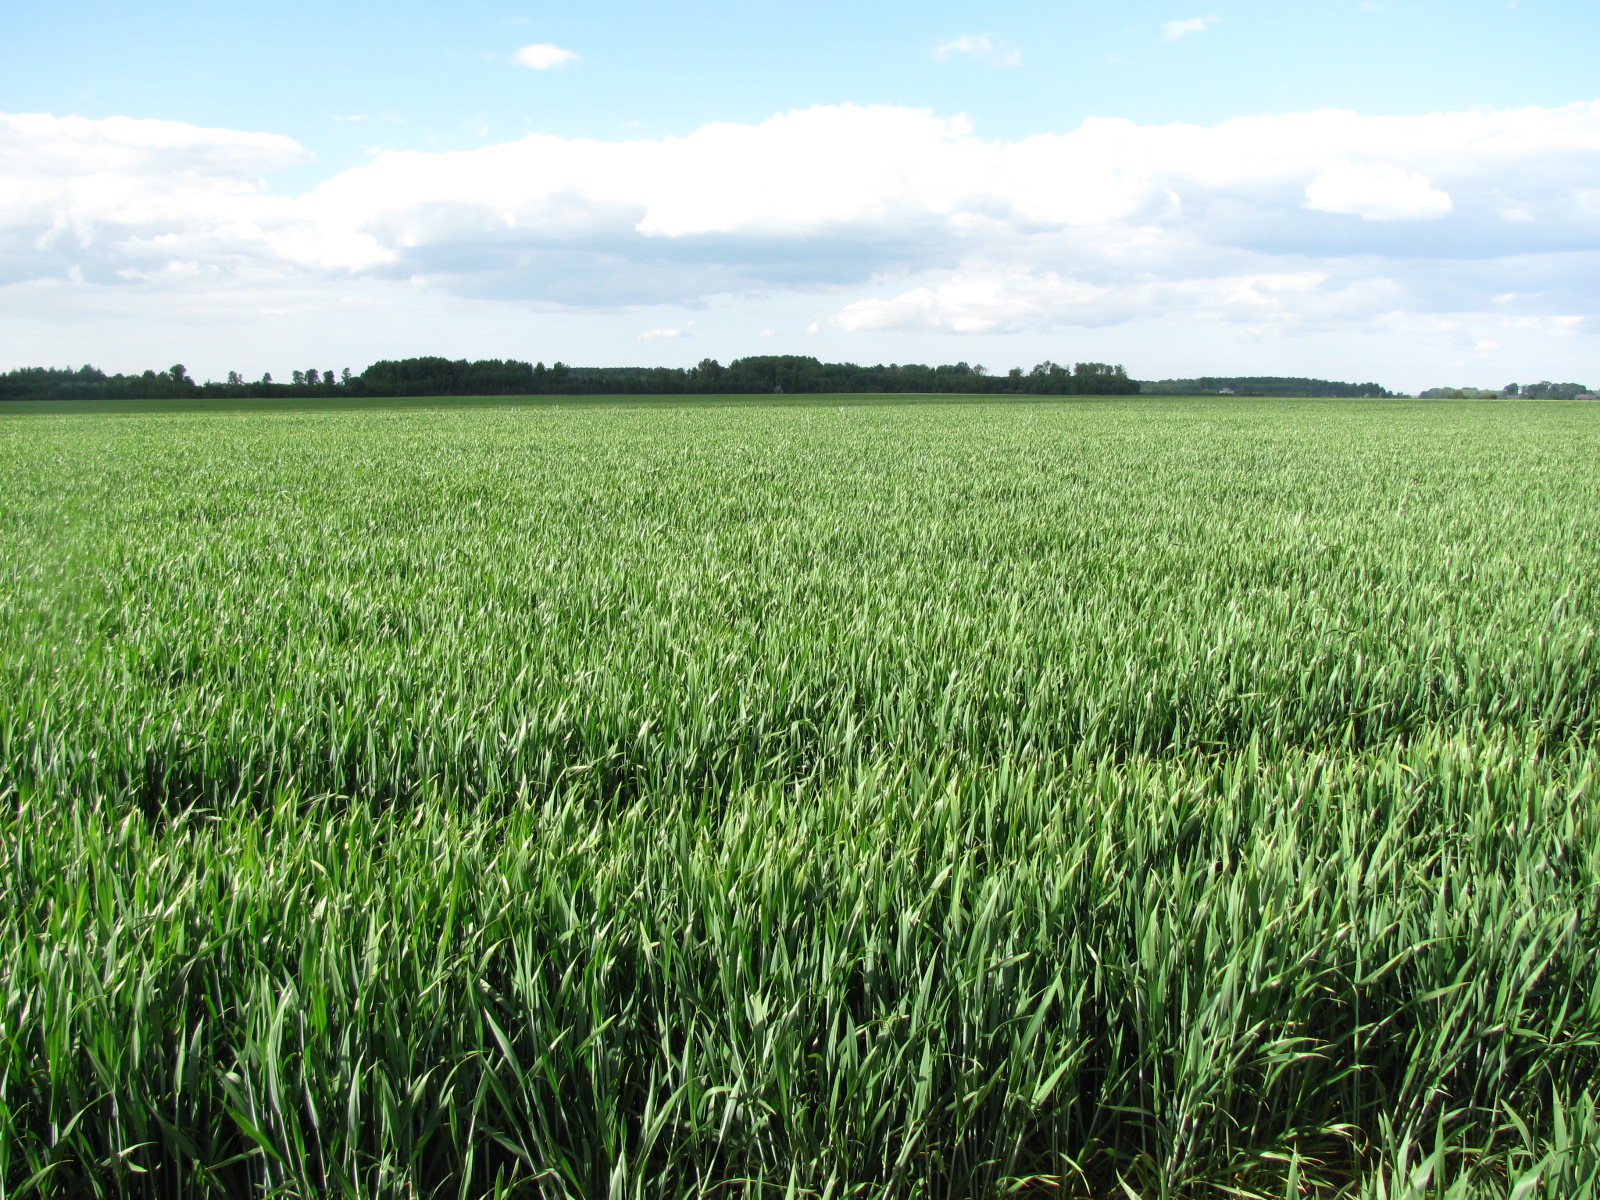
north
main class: Cropland
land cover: Common wheat
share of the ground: > 75 %
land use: Agriculture (excluding fallow land and kitchen gardens)
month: June
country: LV
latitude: 56.3280
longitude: 24.1756
